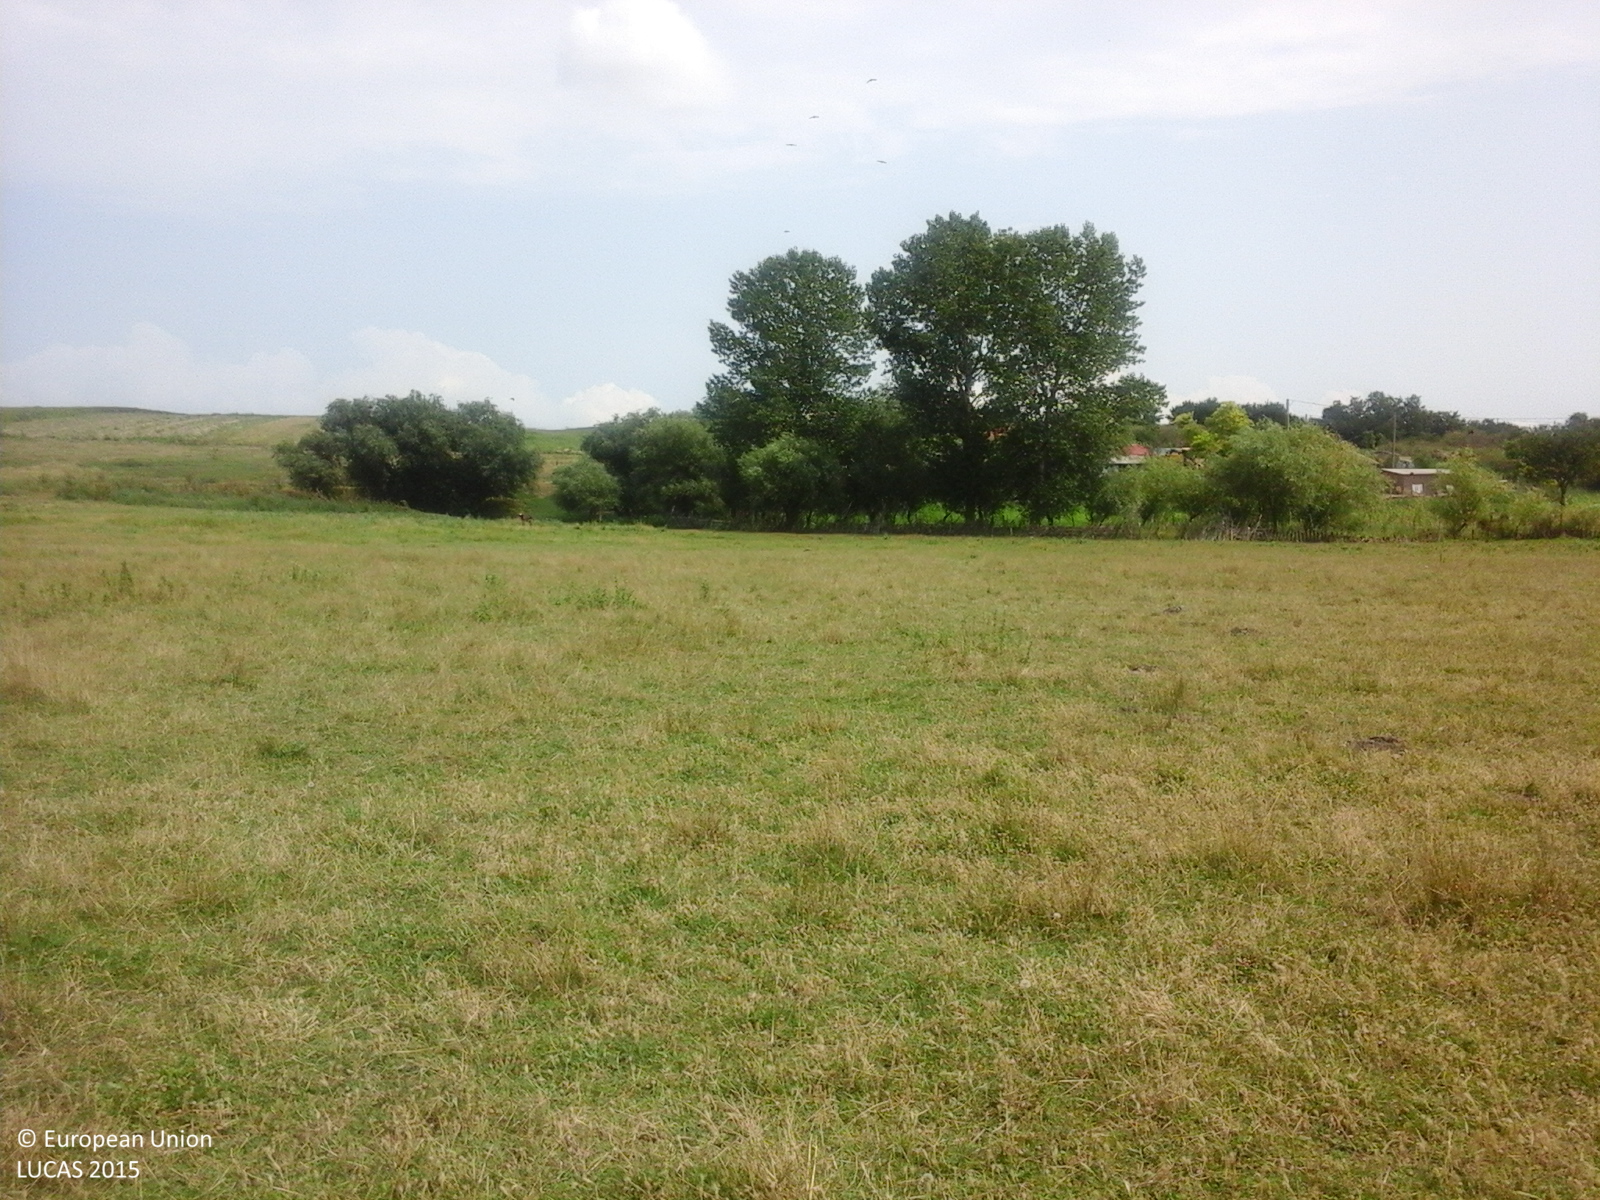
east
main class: Grassland
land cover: Grassland without tree/shrub cover
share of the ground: > 75 %
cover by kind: herbaceous plants 100 %
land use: Agriculture (excluding fallow land and kitchen gardens)
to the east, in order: Grassland without tree/shrub cover; Fences; Grassland with sparse tree/shrub cover; Fences; Broadleaved woodland; Rivers and streams; Broadleaved woodland; Tracks; Grassland without tree/shrub cover; Tracks; Spontaneously vegetated surfaces
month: July
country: RO
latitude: 45.0062
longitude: 28.7495
